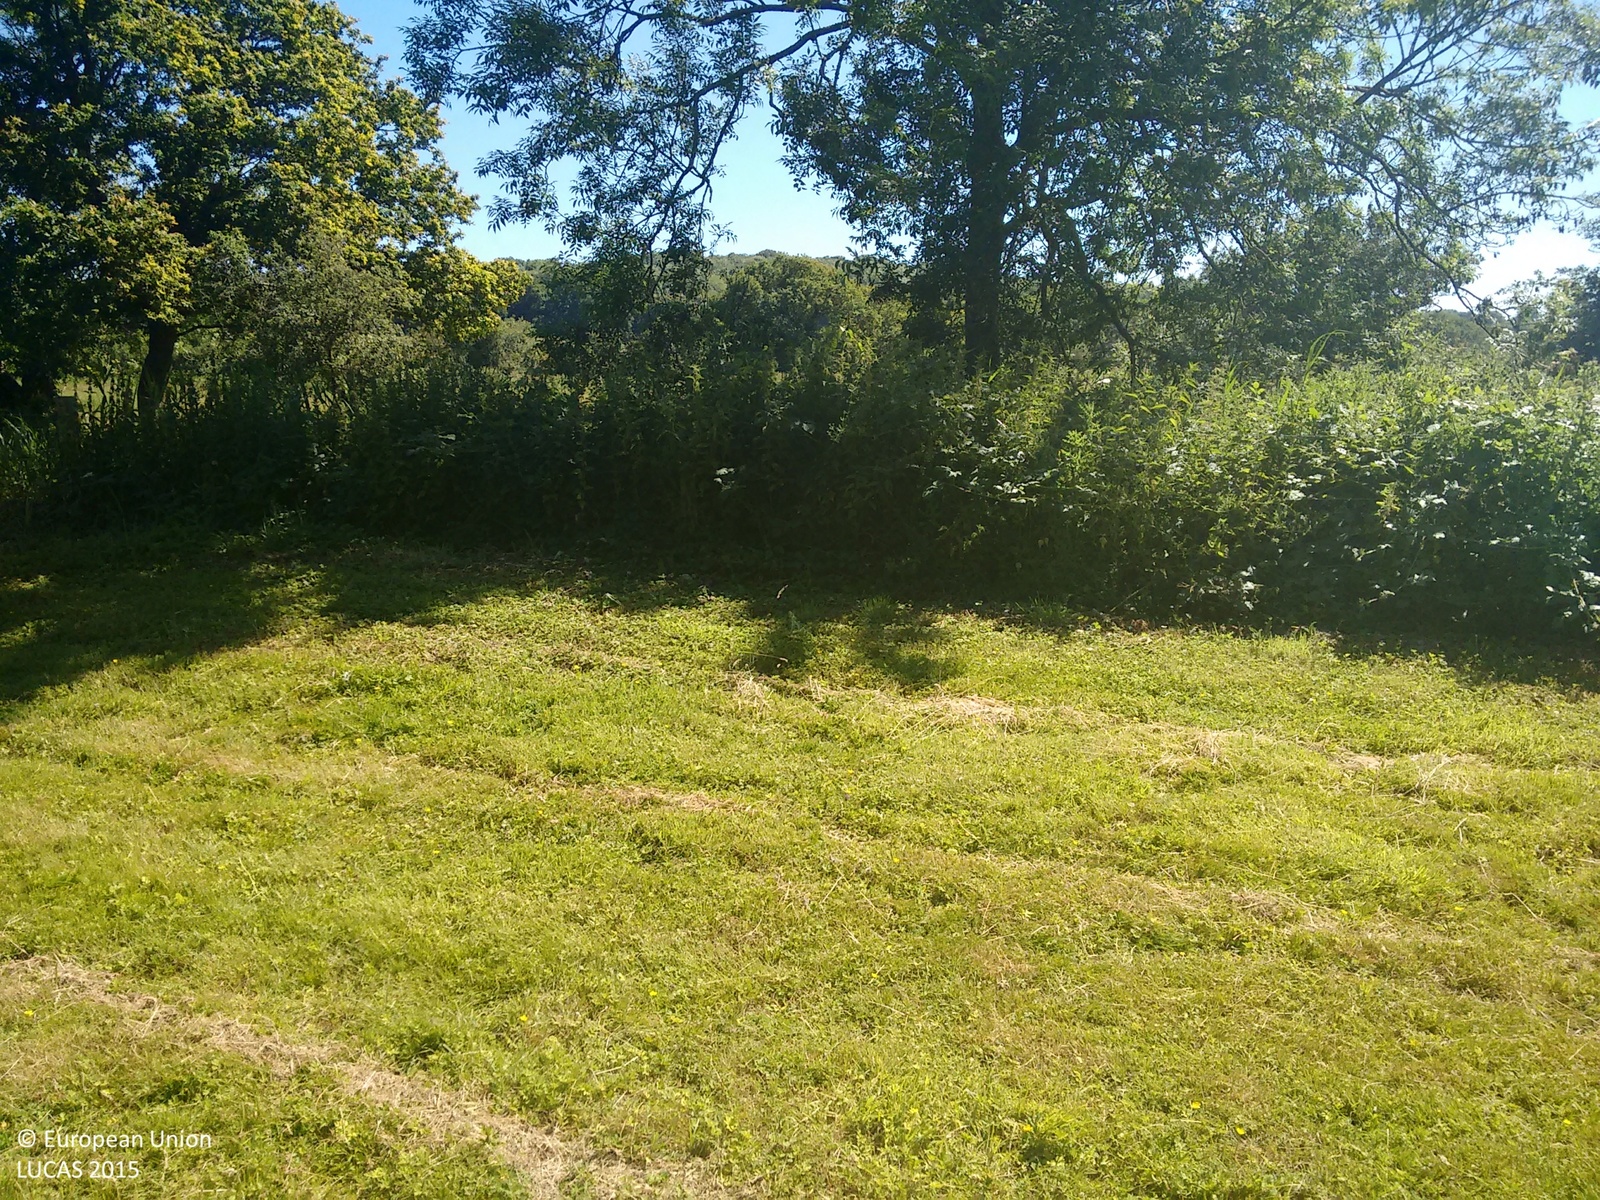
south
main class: Grassland
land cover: Grassland without tree/shrub cover
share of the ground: > 75 %
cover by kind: herbaceous plants 100 %
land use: Agriculture (excluding fallow land and kitchen gardens)
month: June
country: GB
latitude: 50.8554
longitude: -0.5365
